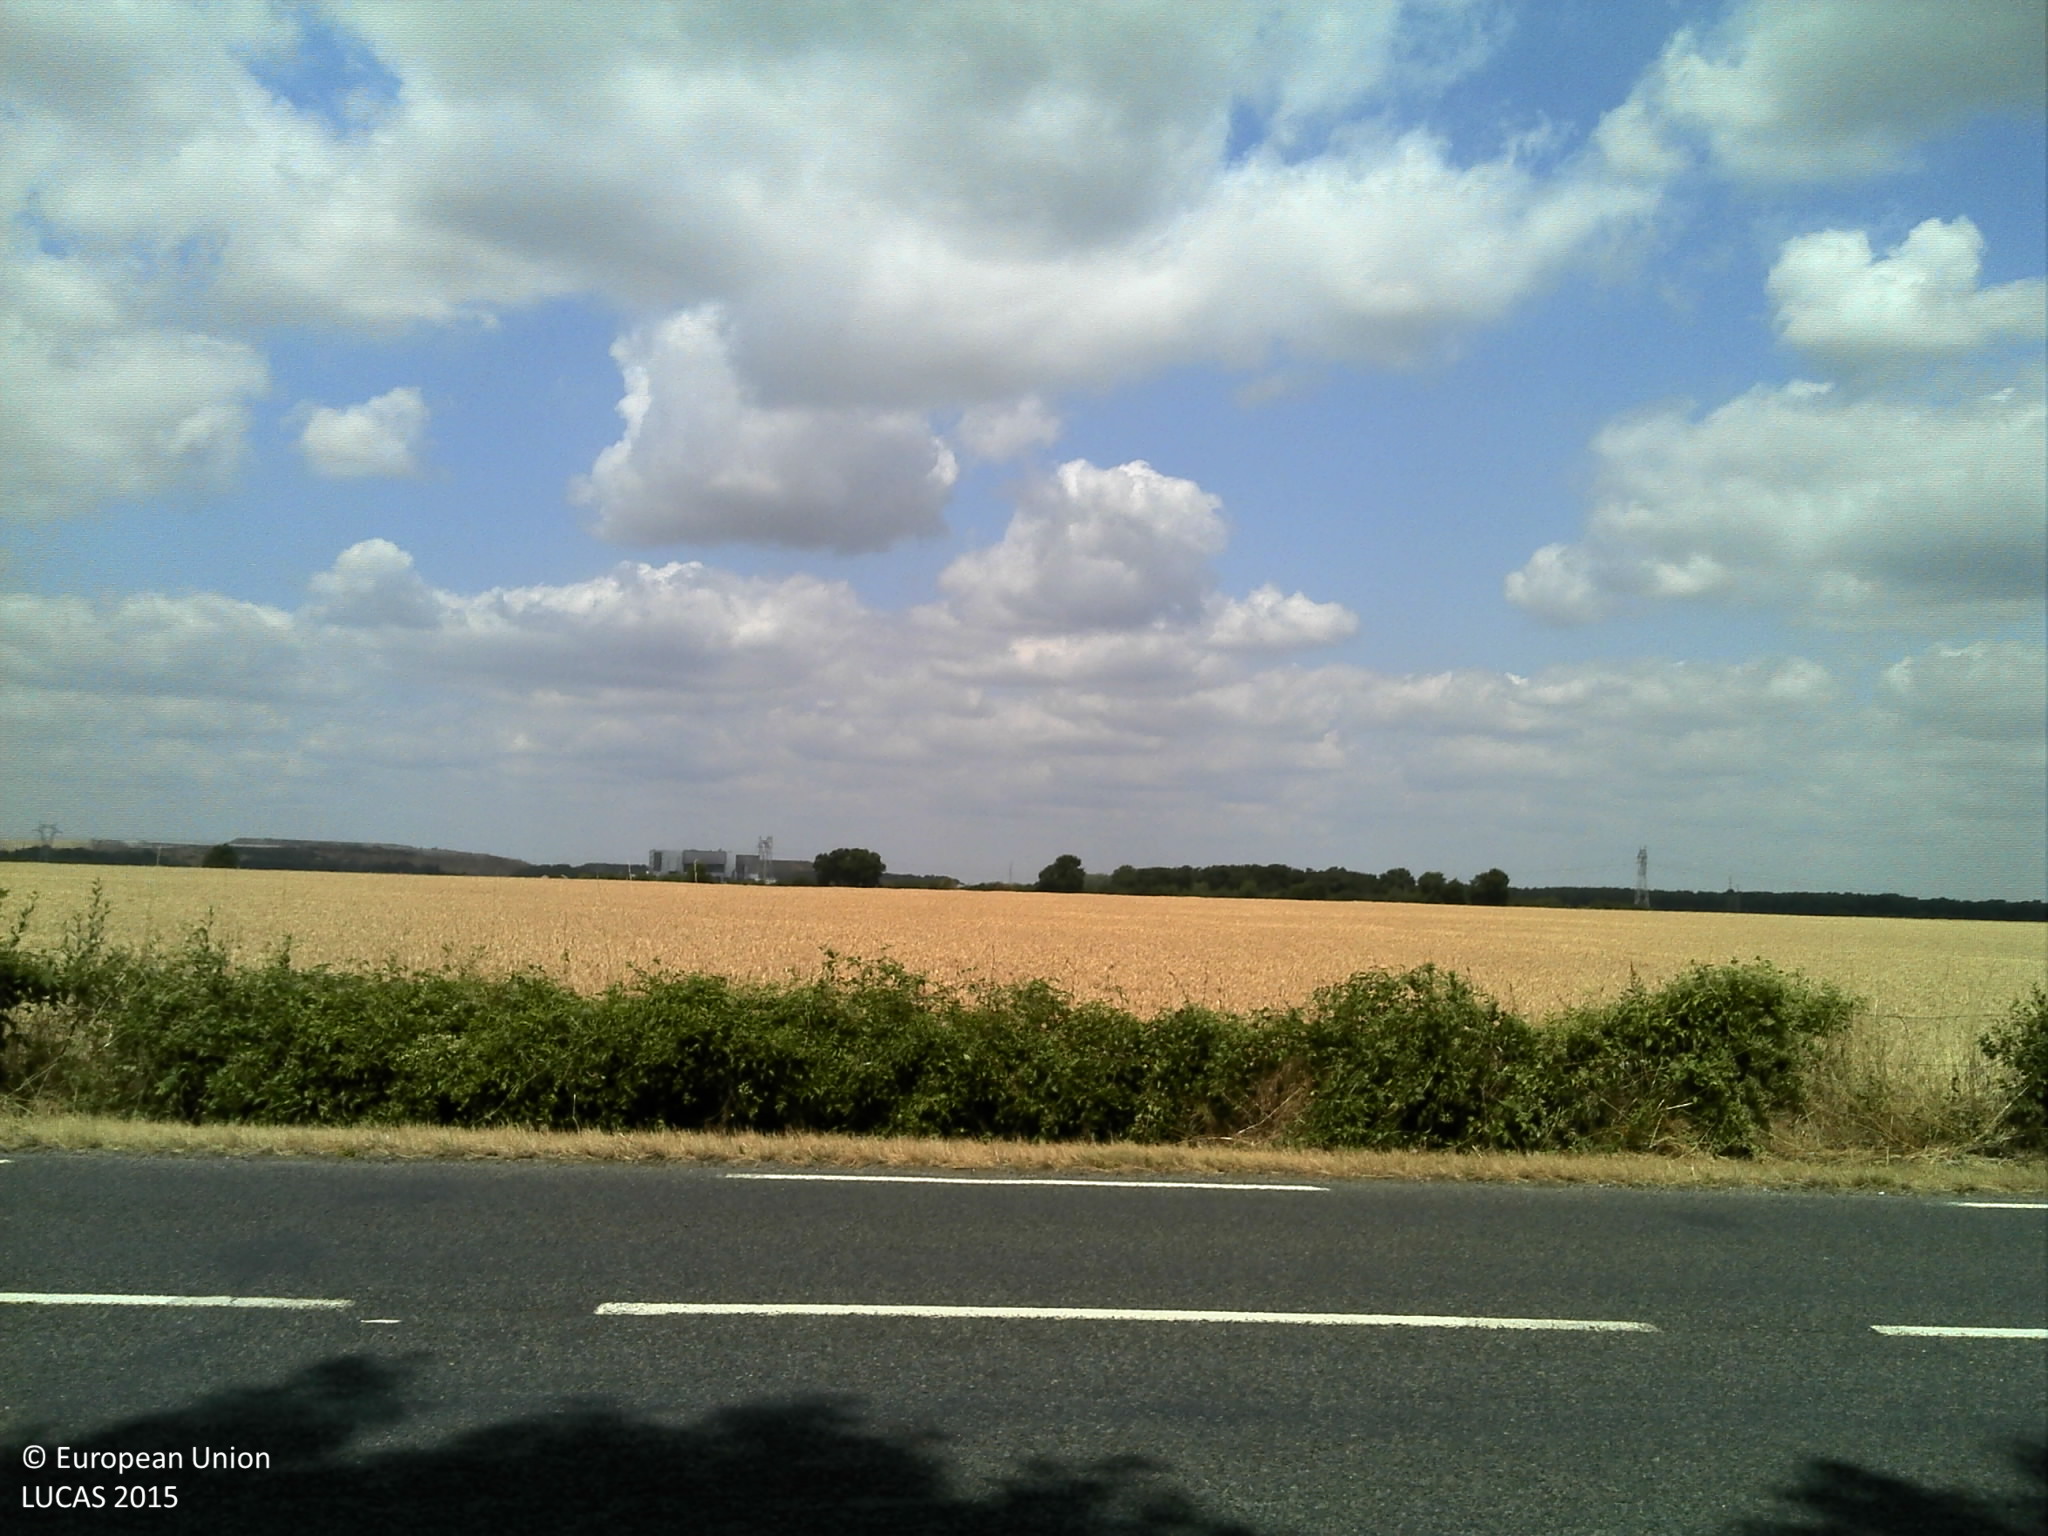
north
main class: Woodland
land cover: Broadleaved woodland
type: beech forest
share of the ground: > 75 %
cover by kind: broadleaved forest trees 100 %
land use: Forestry
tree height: > 5 m
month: July
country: FR
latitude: 48.5763
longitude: 2.4120
